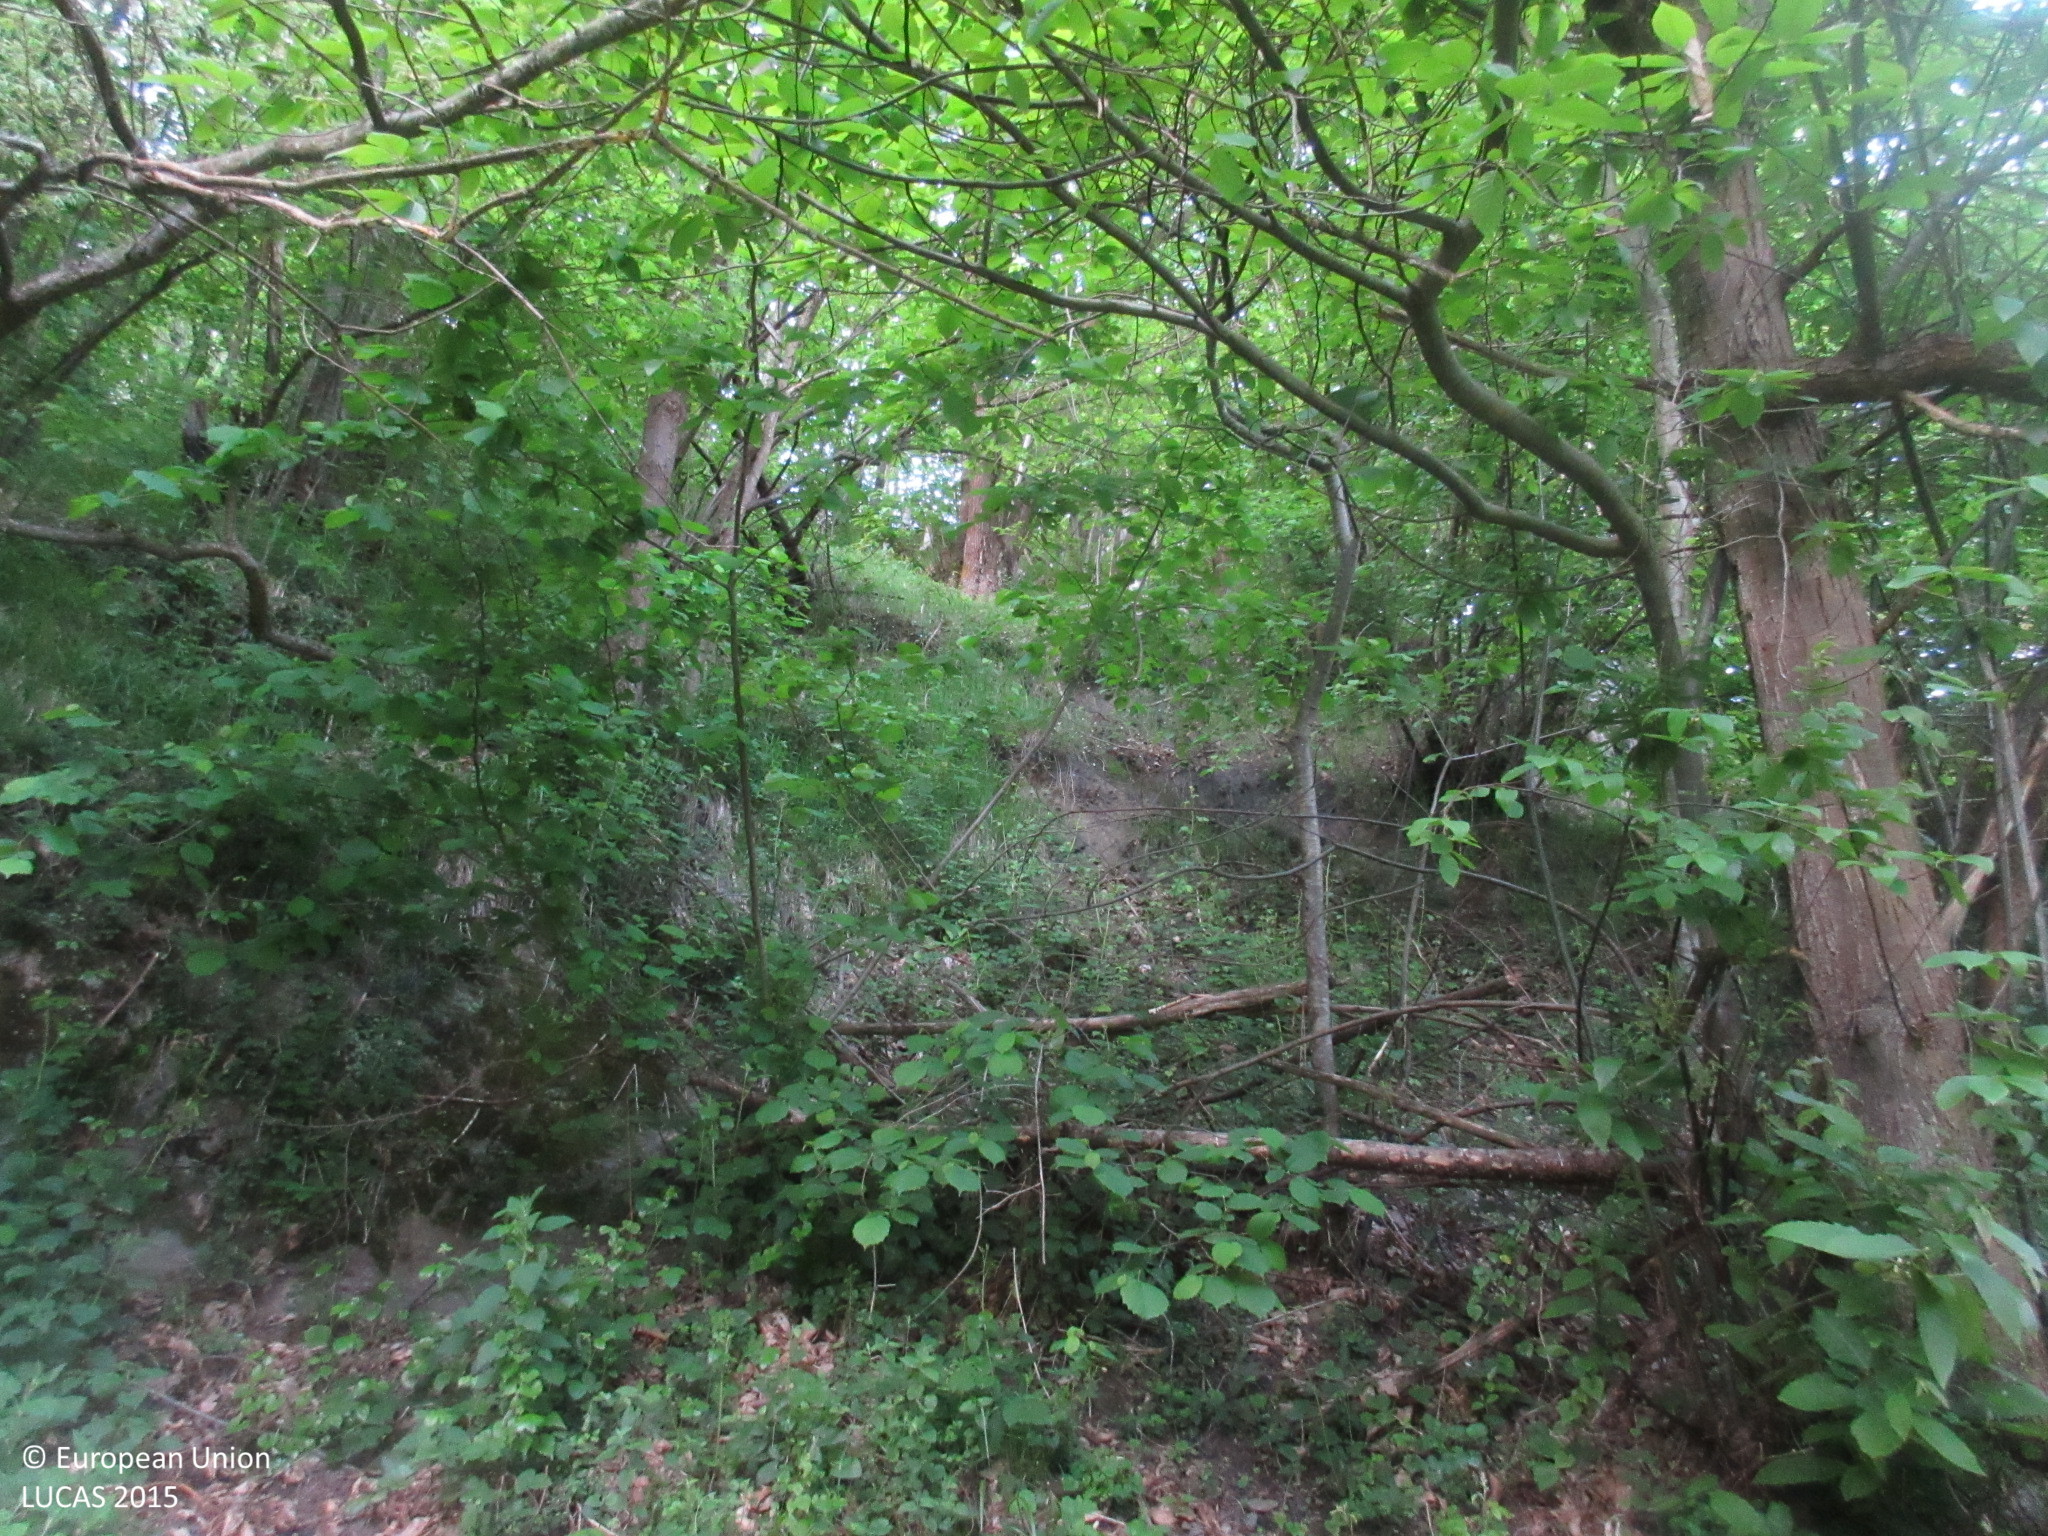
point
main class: Woodland
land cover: Broadleaved woodland
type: thermophilous deciduous forest
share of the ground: > 75 %
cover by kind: broadleaved forest trees 95 %, shrubs 5 %
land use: Semi-natural and natural areas not in use
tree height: > 5 m
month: May
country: ES
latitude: 43.1043
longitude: -5.4980
